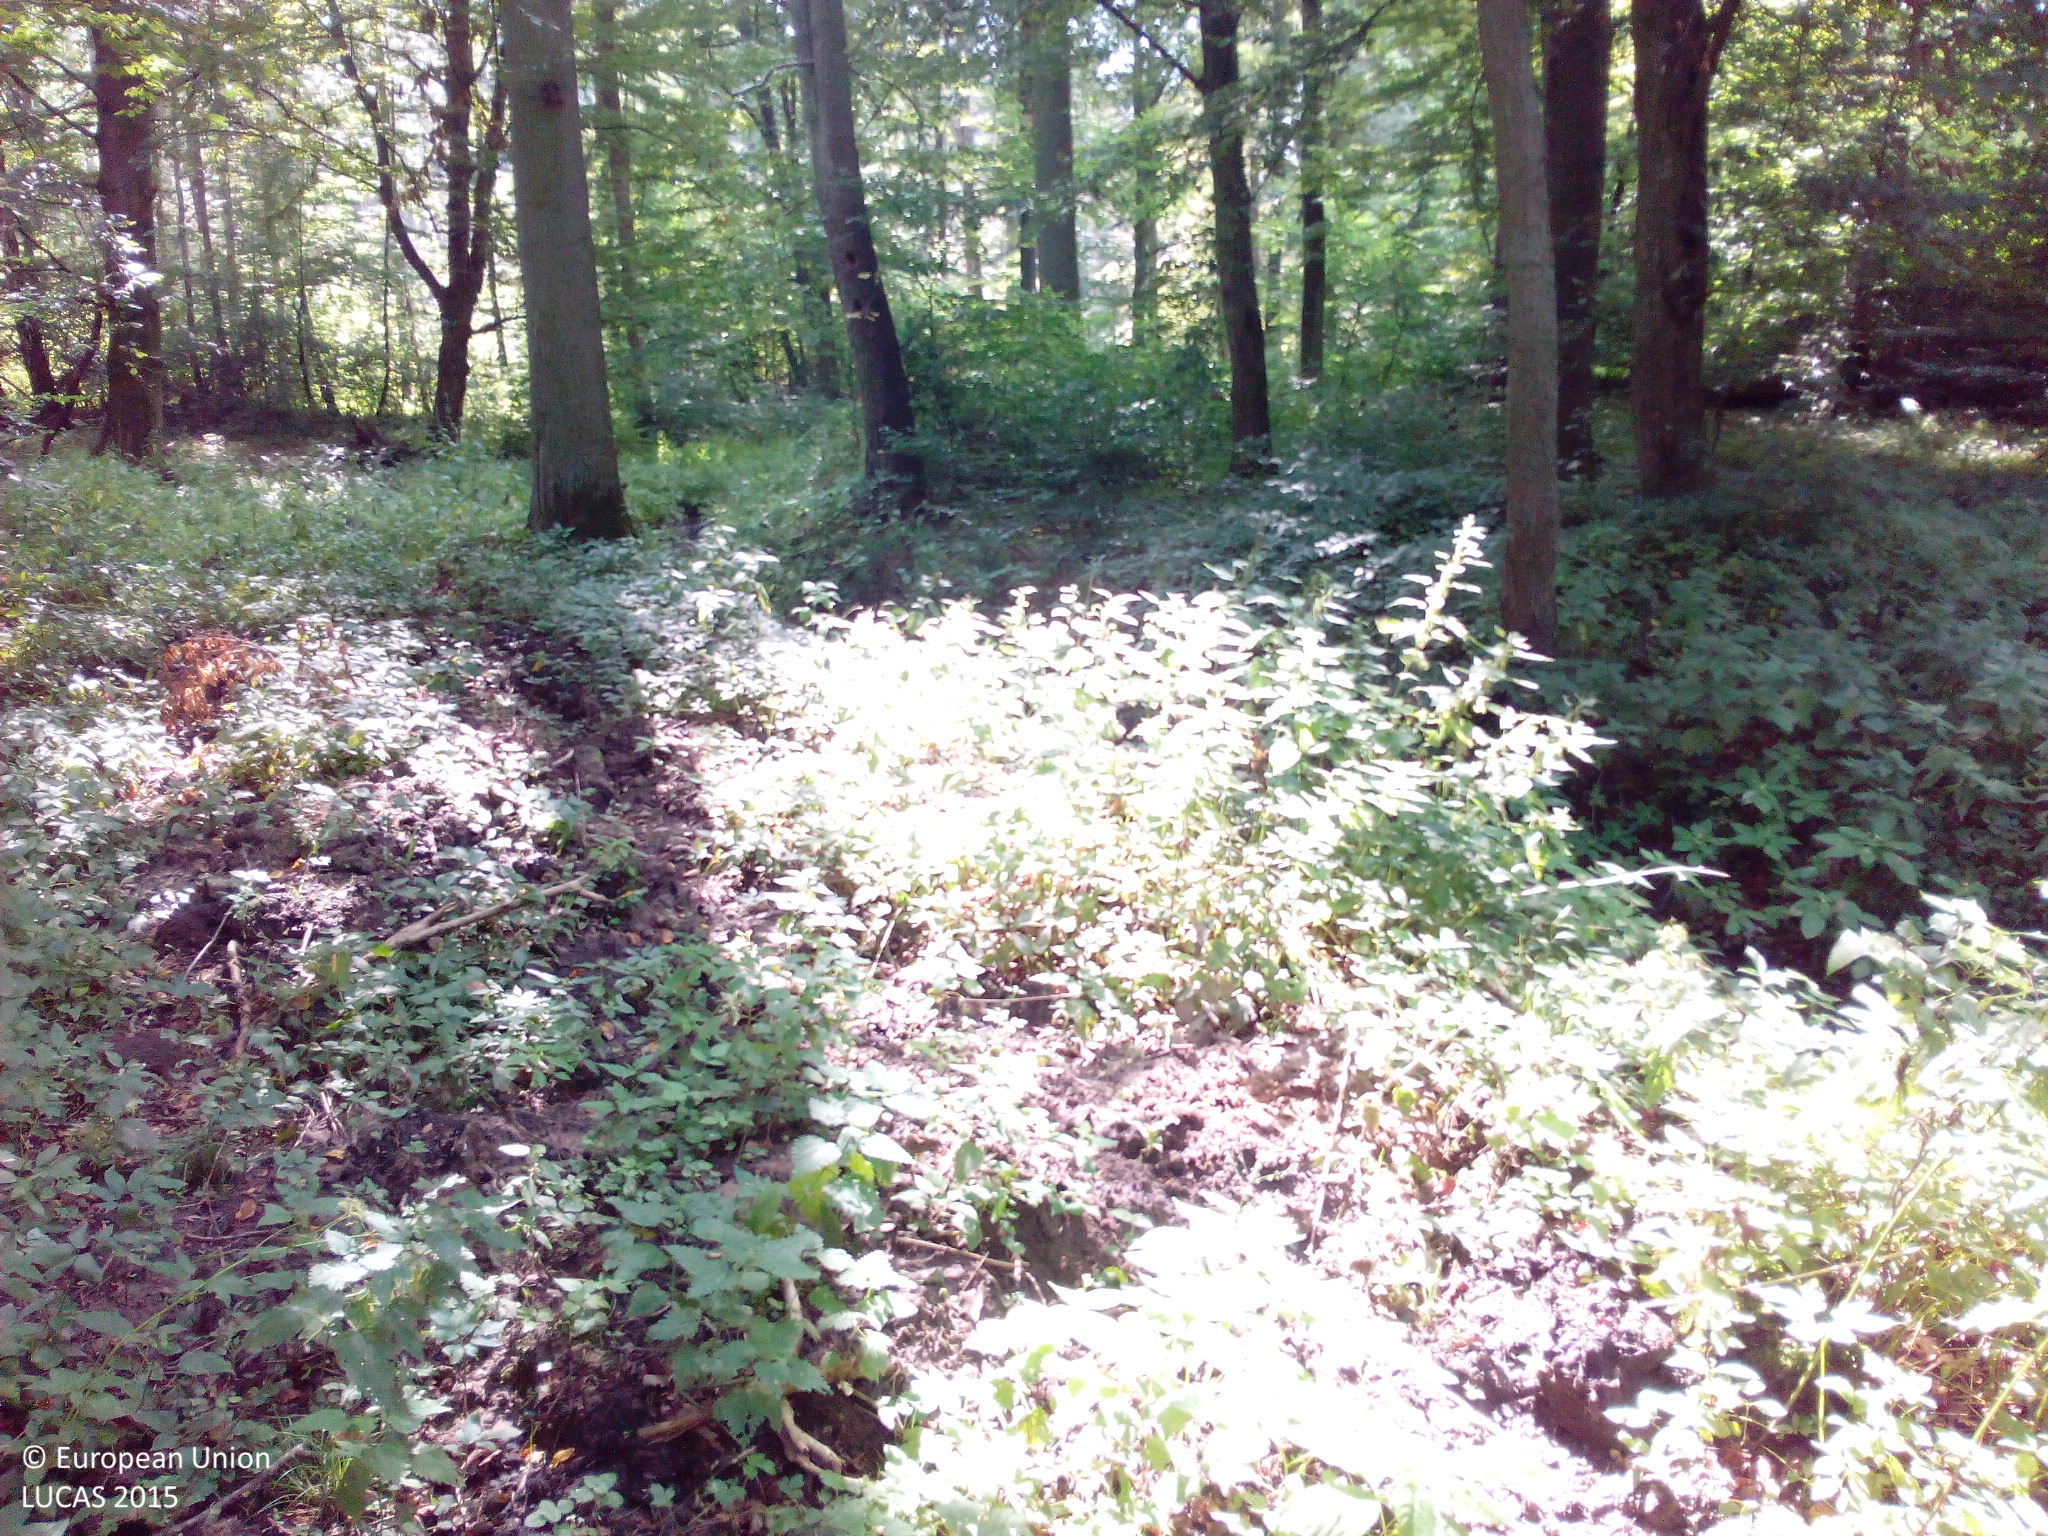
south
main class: Woodland
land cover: Broadleaved woodland
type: mesophytic deciduous forest
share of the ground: > 75 %
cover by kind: broadleaved forest trees 90 %, shrubs 5 %, herbaceous plants 5 %
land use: Forestry
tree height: > 5 m
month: August
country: DE
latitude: 54.2181
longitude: 12.6521
